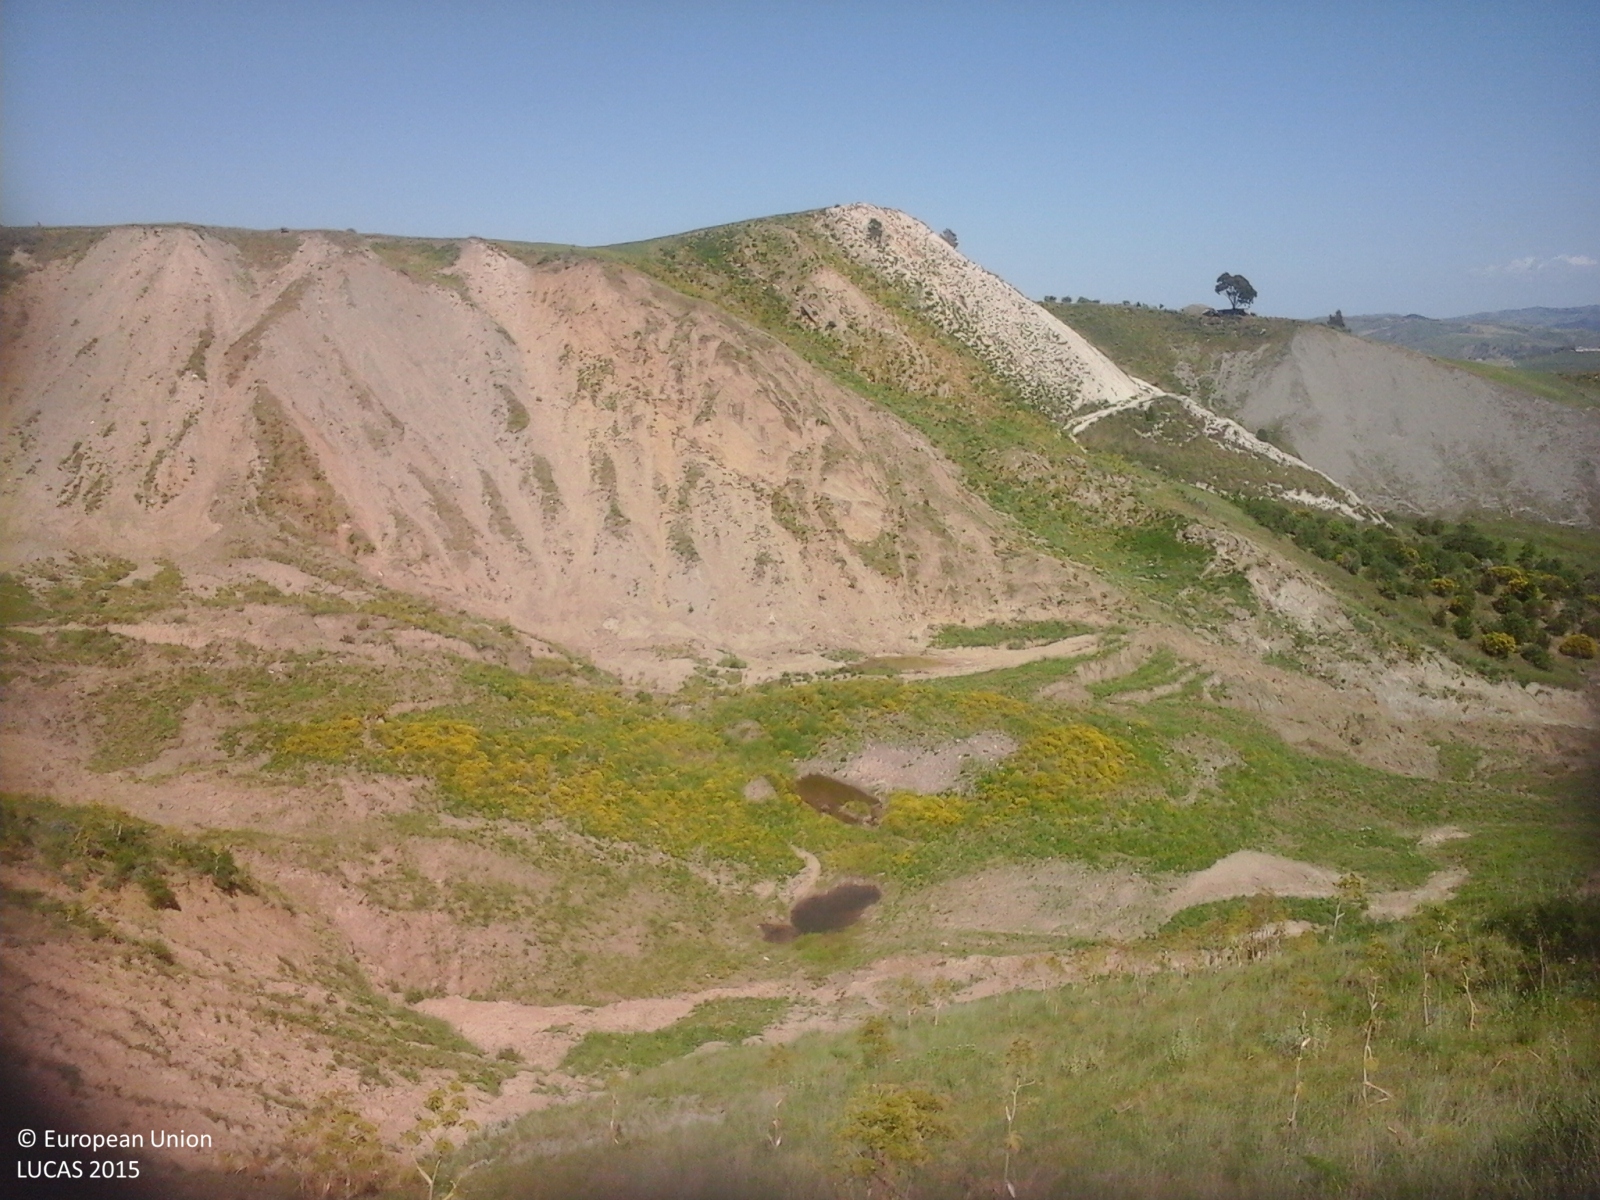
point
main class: Grassland
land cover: Grassland without tree/shrub cover
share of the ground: > 75 %
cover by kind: herbaceous plants 85 %, consolidated bare surface 15 %
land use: Agriculture (excluding fallow land and kitchen gardens)
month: May
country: IT
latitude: 37.5631
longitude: 13.7869
